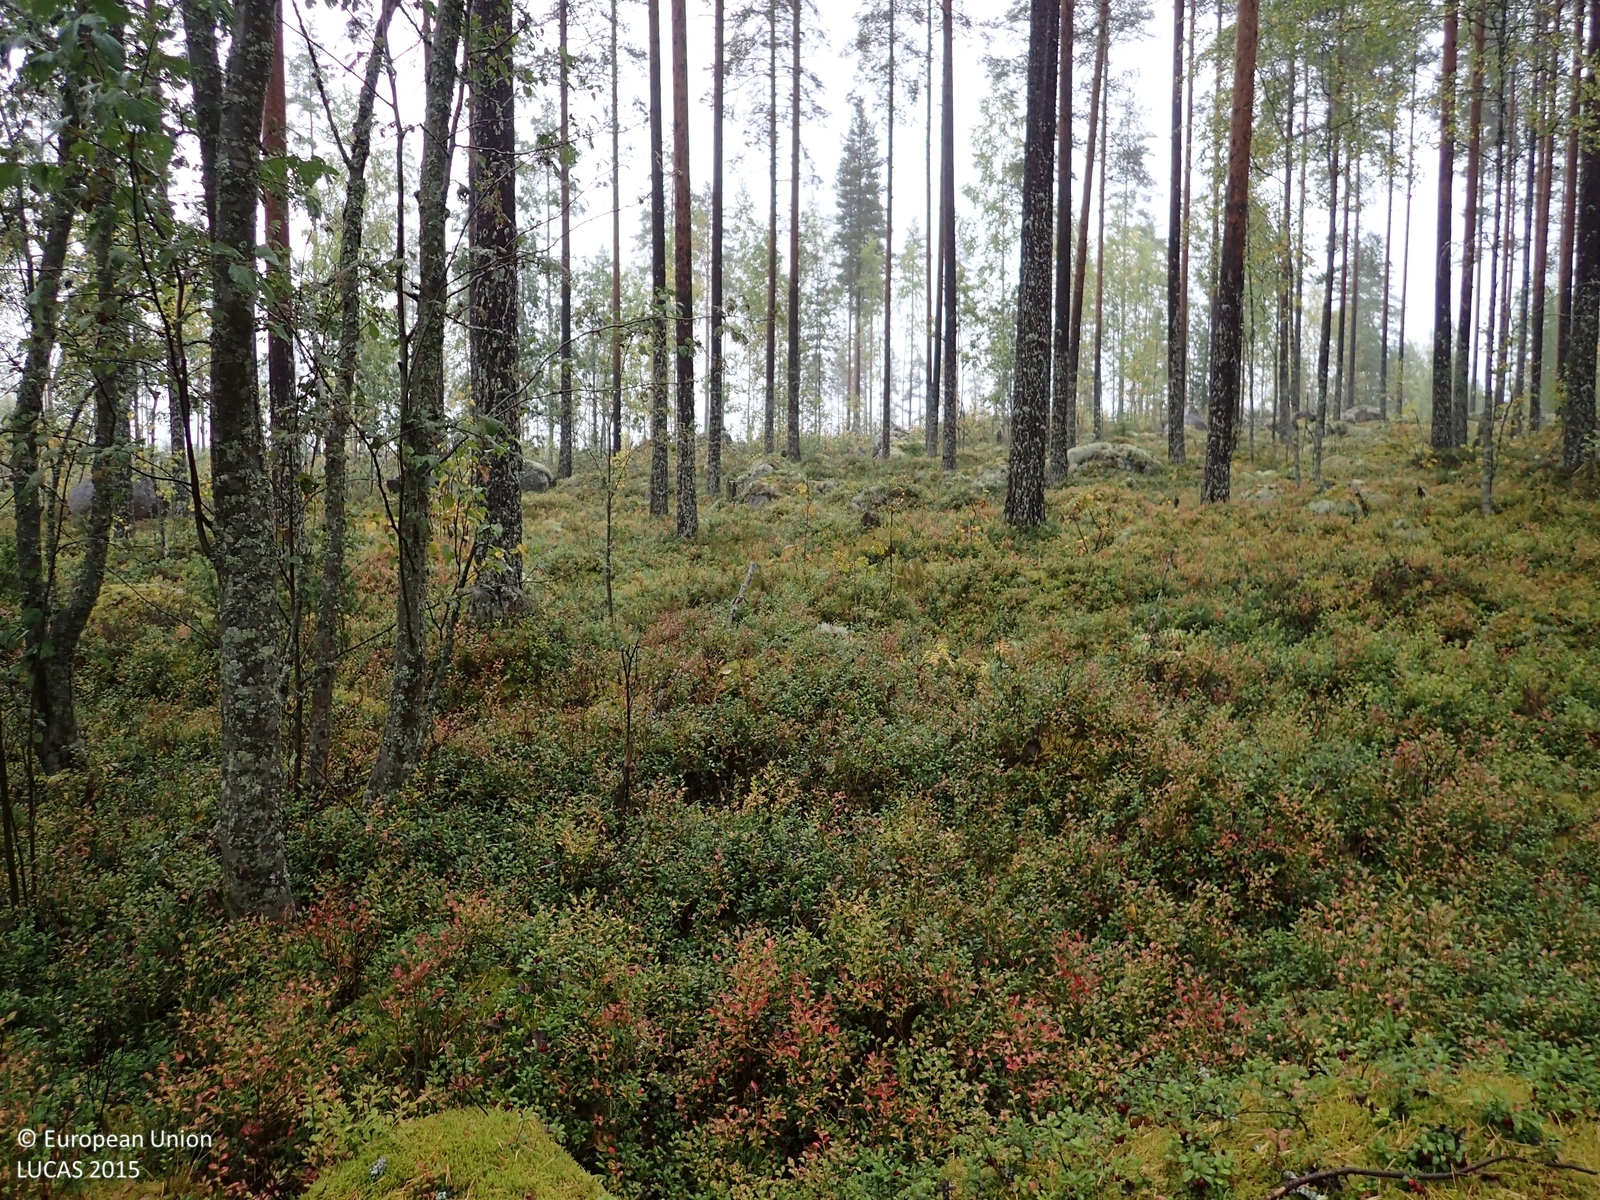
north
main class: Woodland
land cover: Pine dominated mixed woodland
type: boreal forest
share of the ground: 50 - 75 %
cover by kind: coniferous forest trees 55 %, broadleaved forest trees 20 %, shrubs 20 %, lichens and mosses 5 %
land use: Forestry
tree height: > 5 m
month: September
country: FI
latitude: 63.2270
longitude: 25.2817
